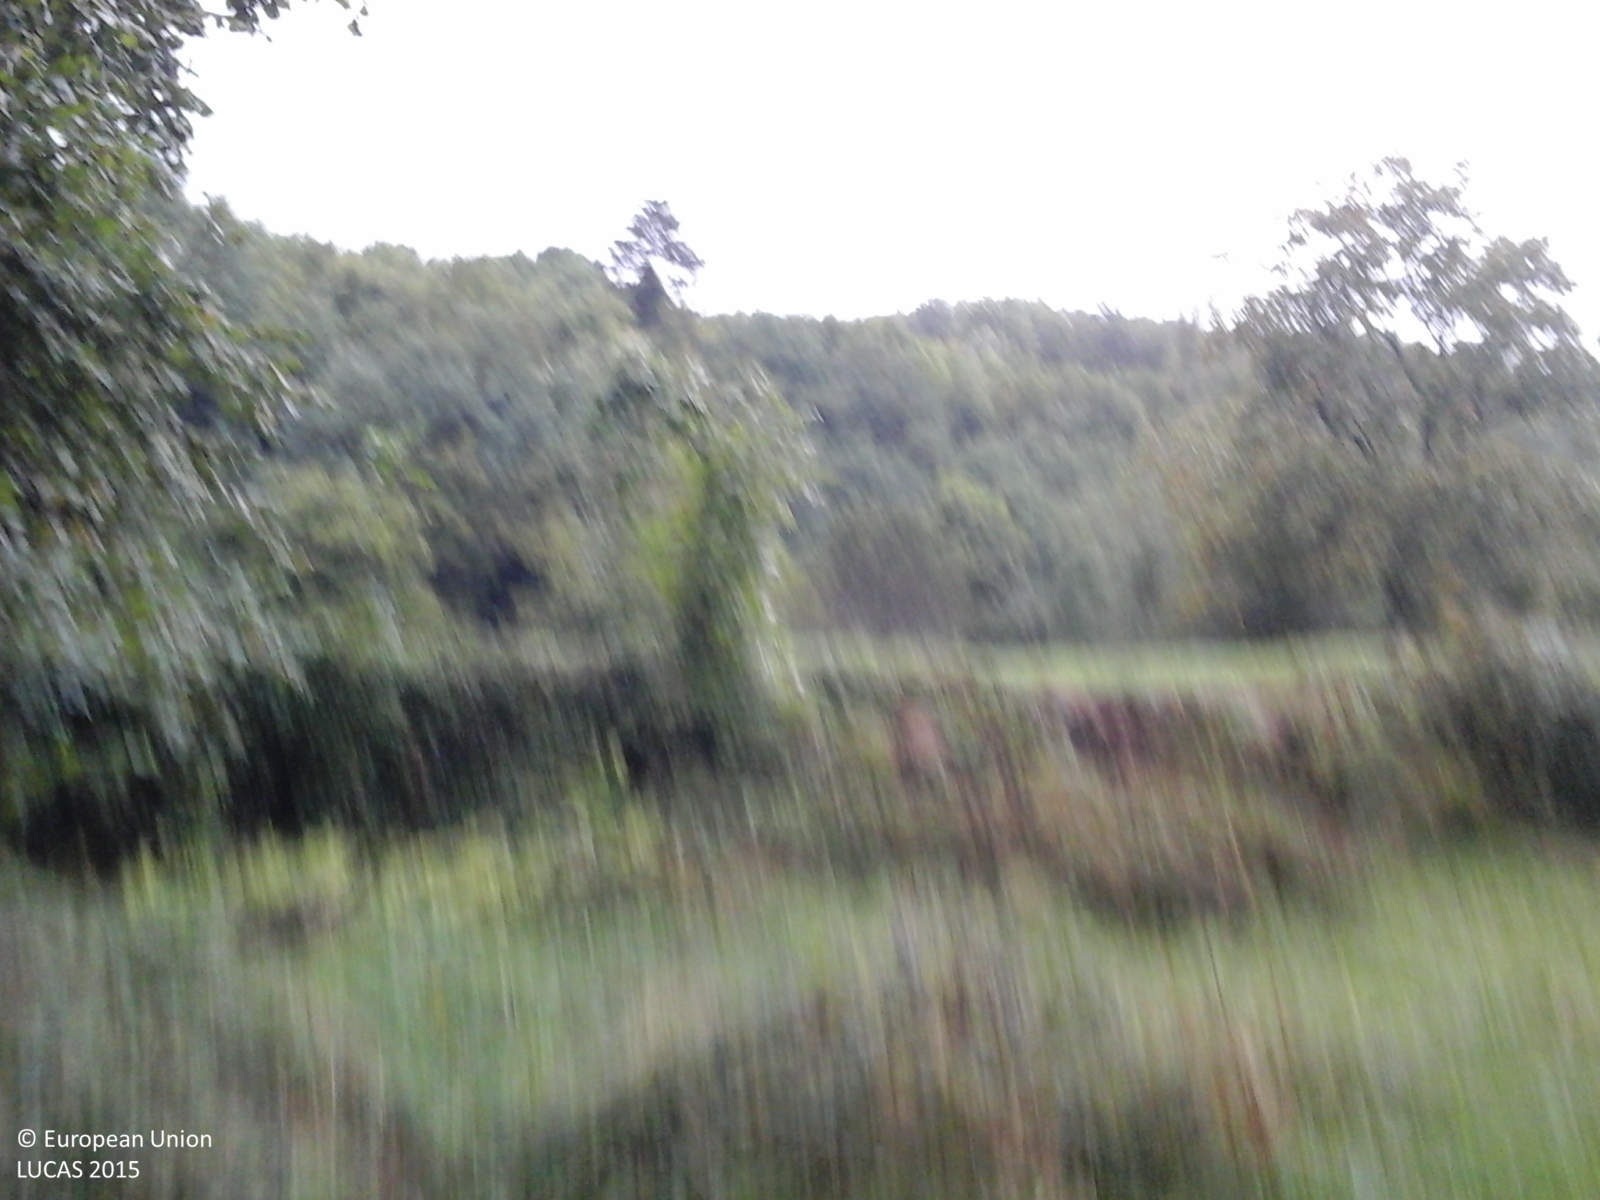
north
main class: Woodland
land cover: Broadleaved woodland
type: thermophilous deciduous forest
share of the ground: > 75 %
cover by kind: broadleaved forest trees 60 %, herbaceous plants 30 %, shrubs 10 %
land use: Semi-natural and natural areas not in use
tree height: > 5 m
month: September
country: IT
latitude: 44.4568
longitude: 9.3605
